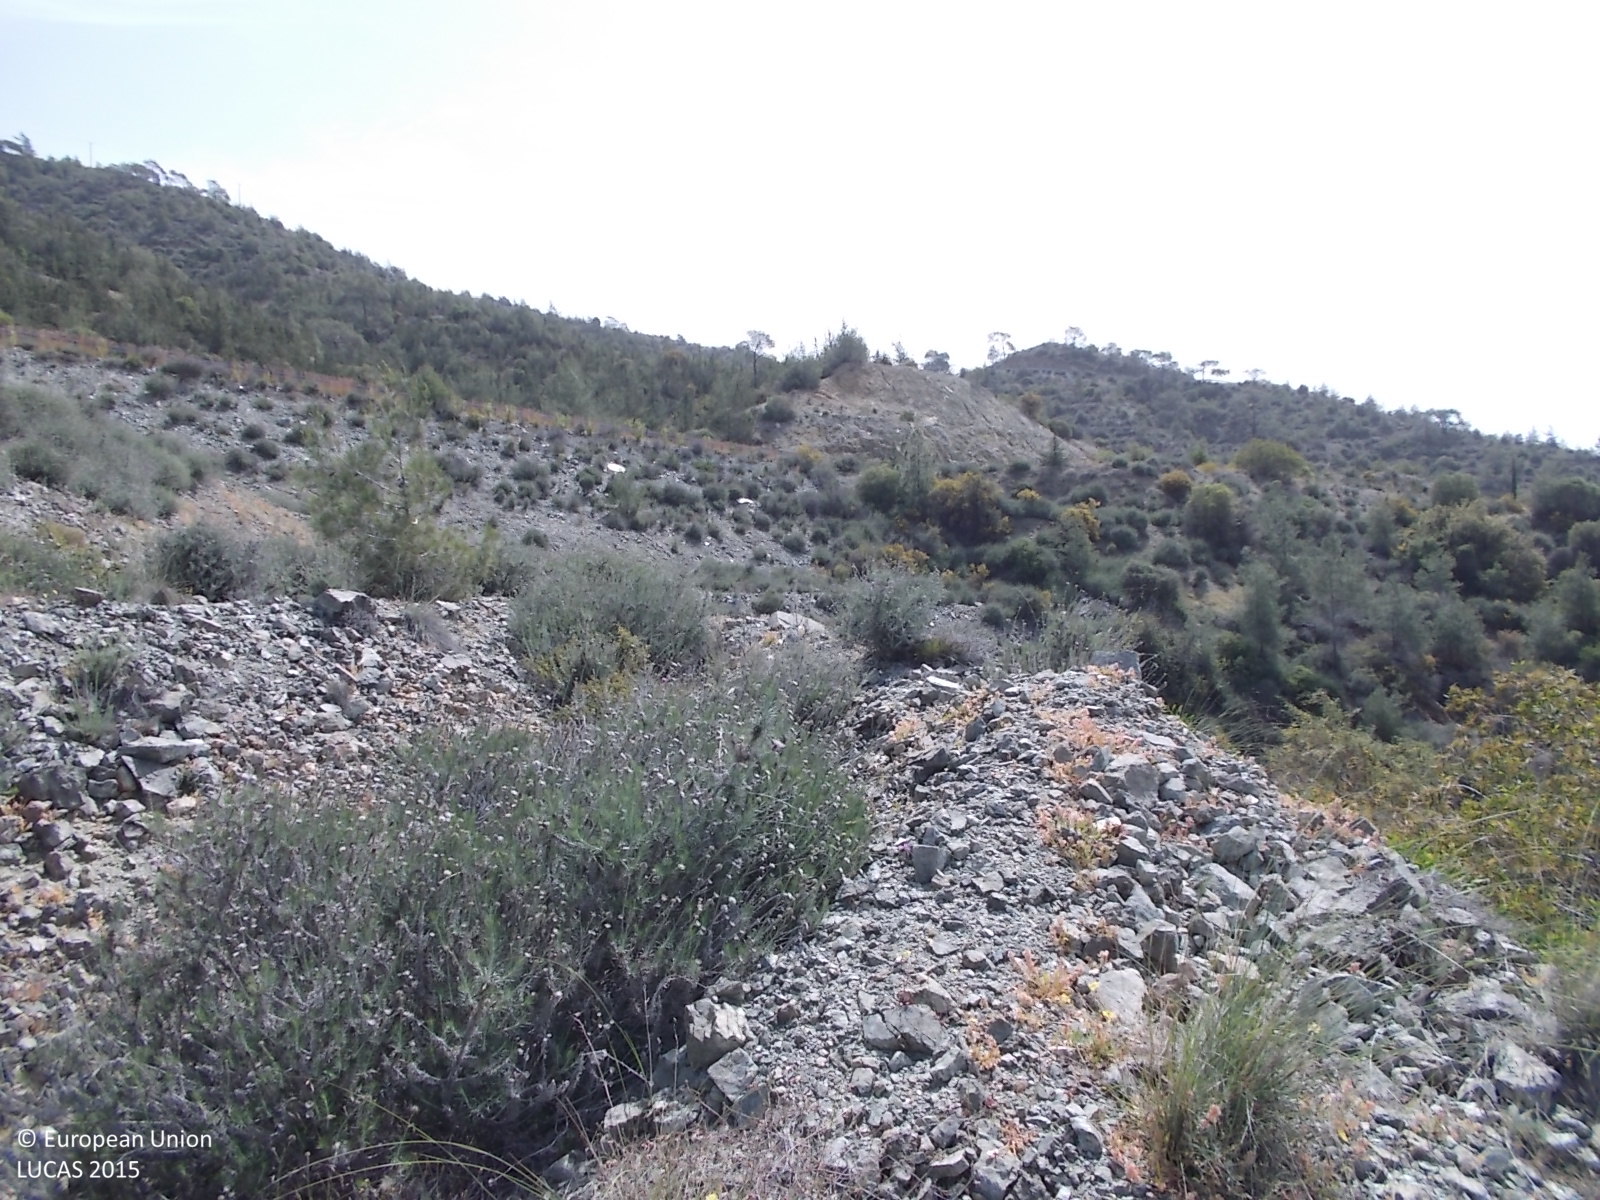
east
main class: Shrubland
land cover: Shrubland with sparse tree cover
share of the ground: > 75 %
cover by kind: shrubs 95 %, coniferous forest trees 5 %
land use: Semi-natural and natural areas not in use
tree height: > 5 m
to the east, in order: Shrubland with sparse tree cover; Rocks and stones; Pine dominated coniferous woodland; Shrubland without tree cover; Paved roads, cycling and walking lanes
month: April
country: CY
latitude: 34.7912
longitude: 33.1568
